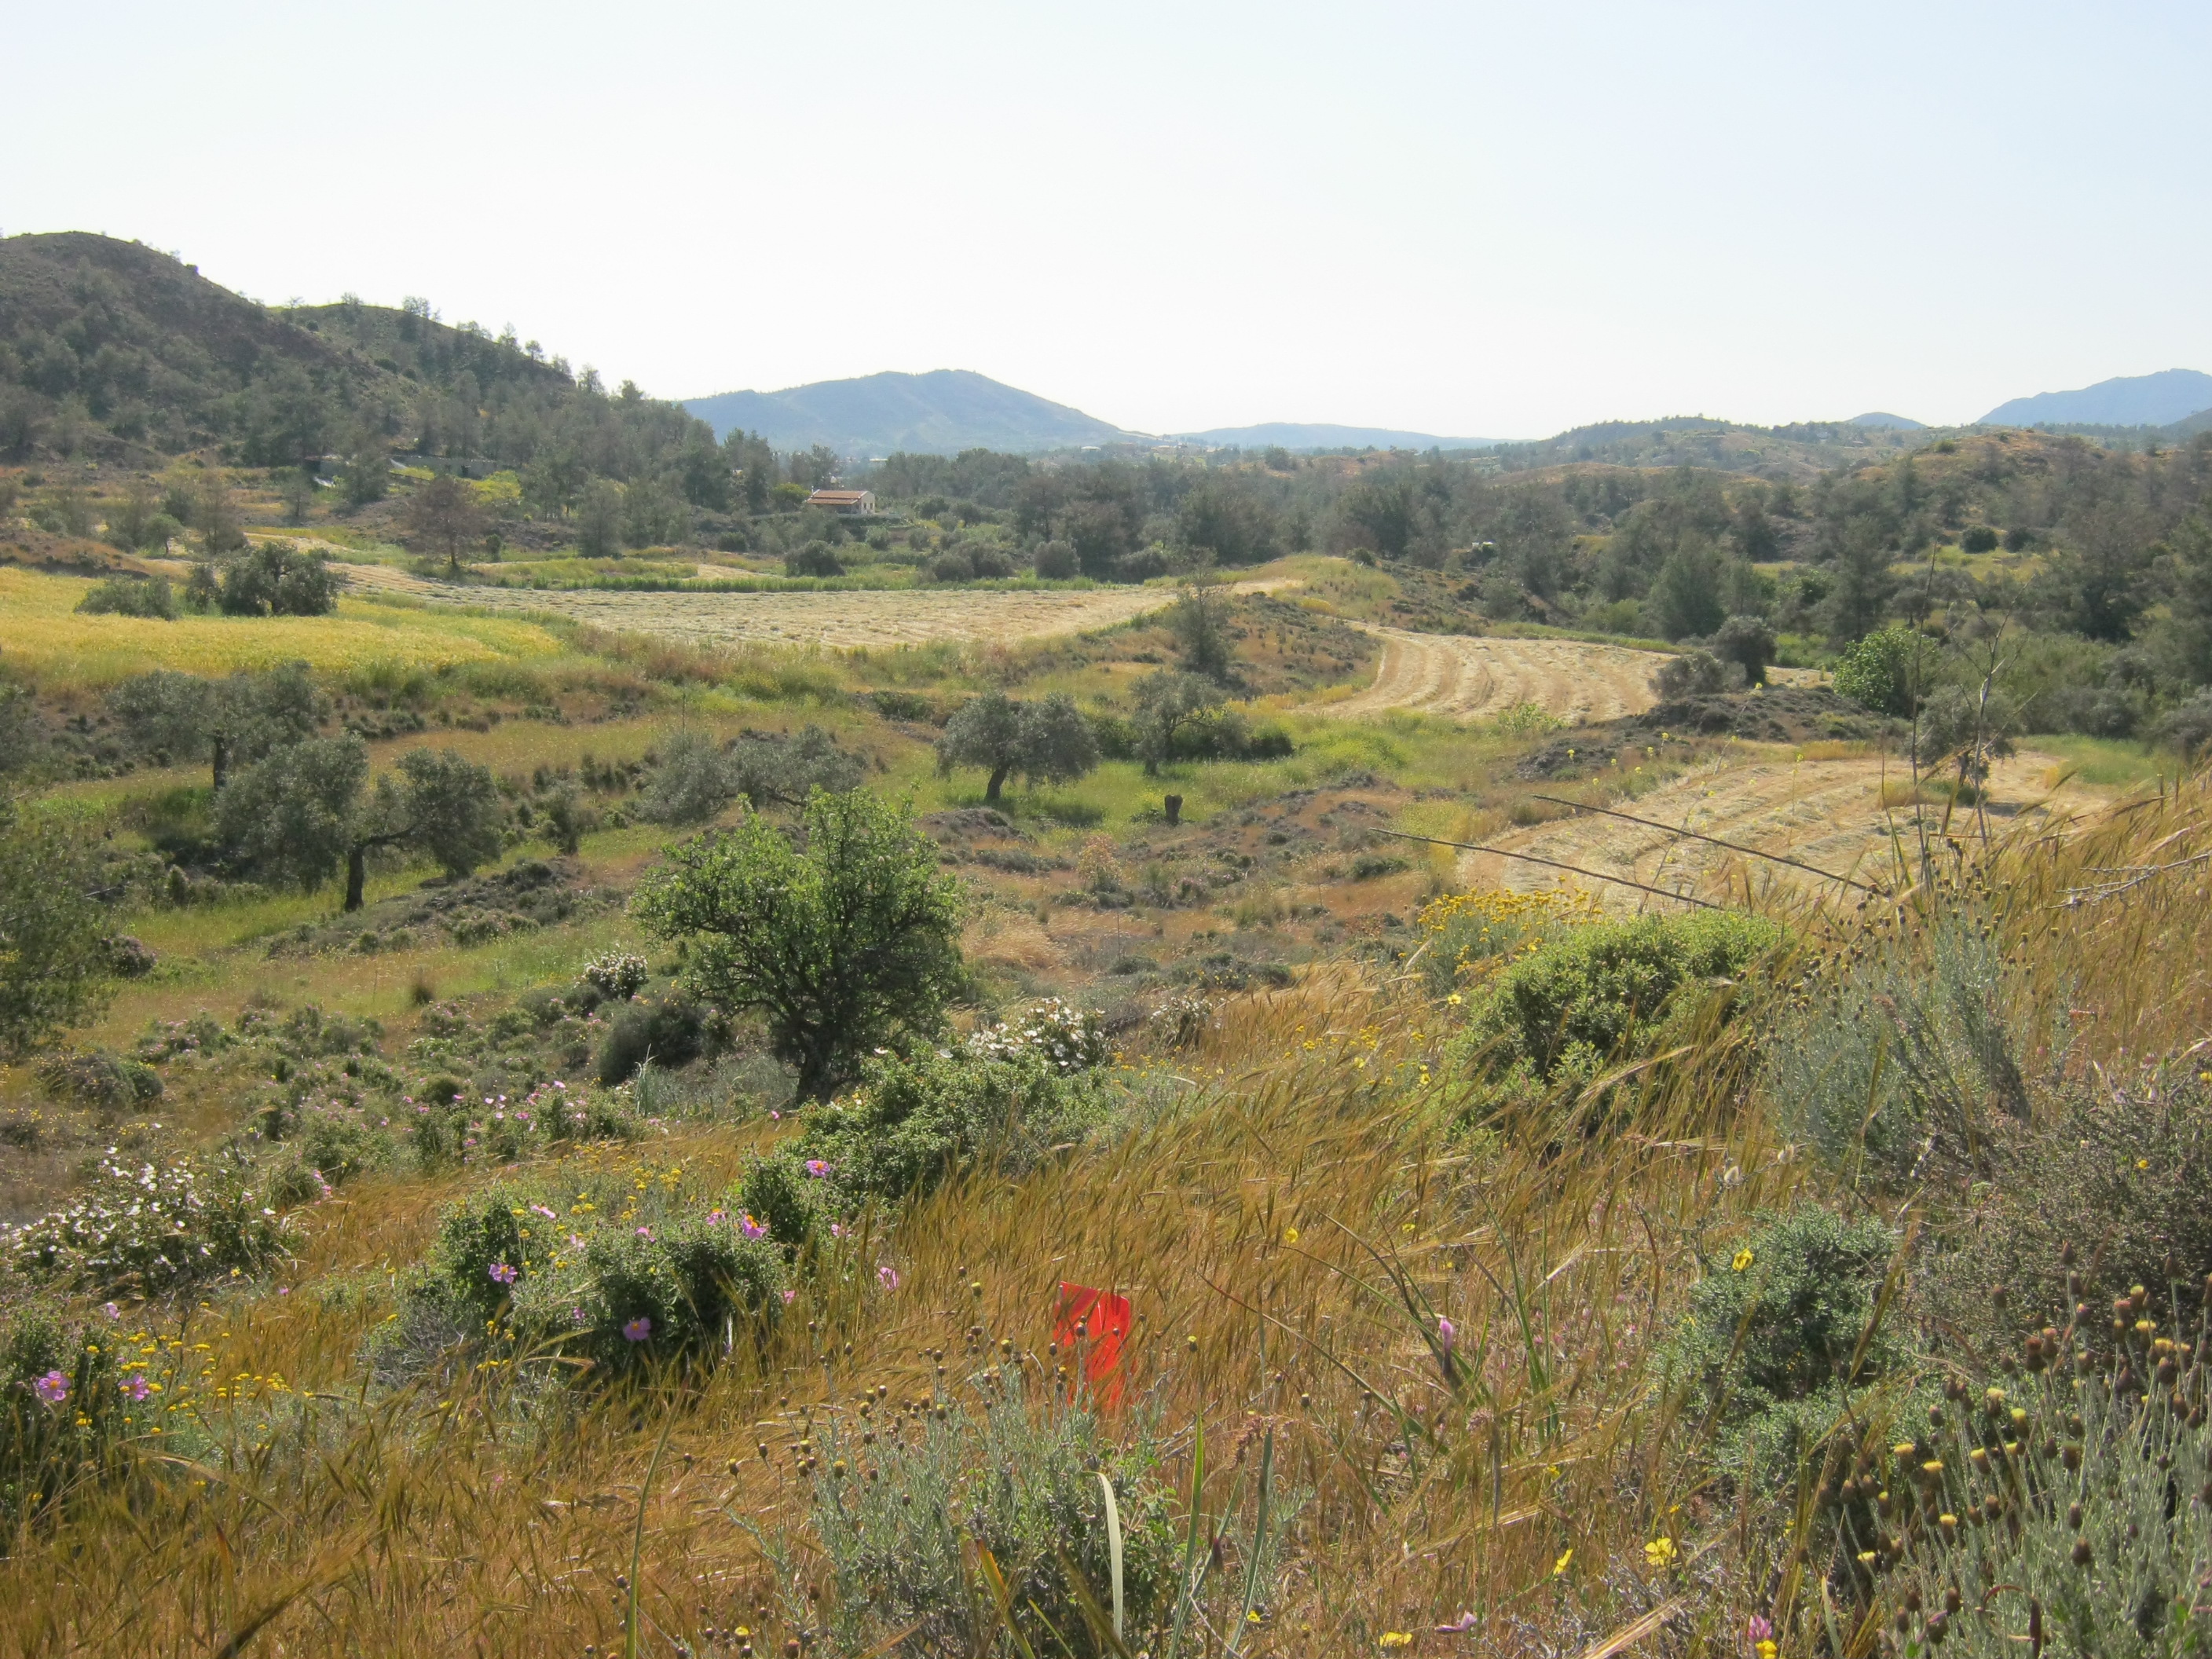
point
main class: Shrubland
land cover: Shrubland with sparse tree cover
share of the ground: 25 - 50 %
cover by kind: herbaceous plants 50 %, shrubs 45 %, broadleaved forest trees 5 %
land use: Semi-natural and natural areas not in use
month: April
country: CY
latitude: 34.9608
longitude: 33.3718
